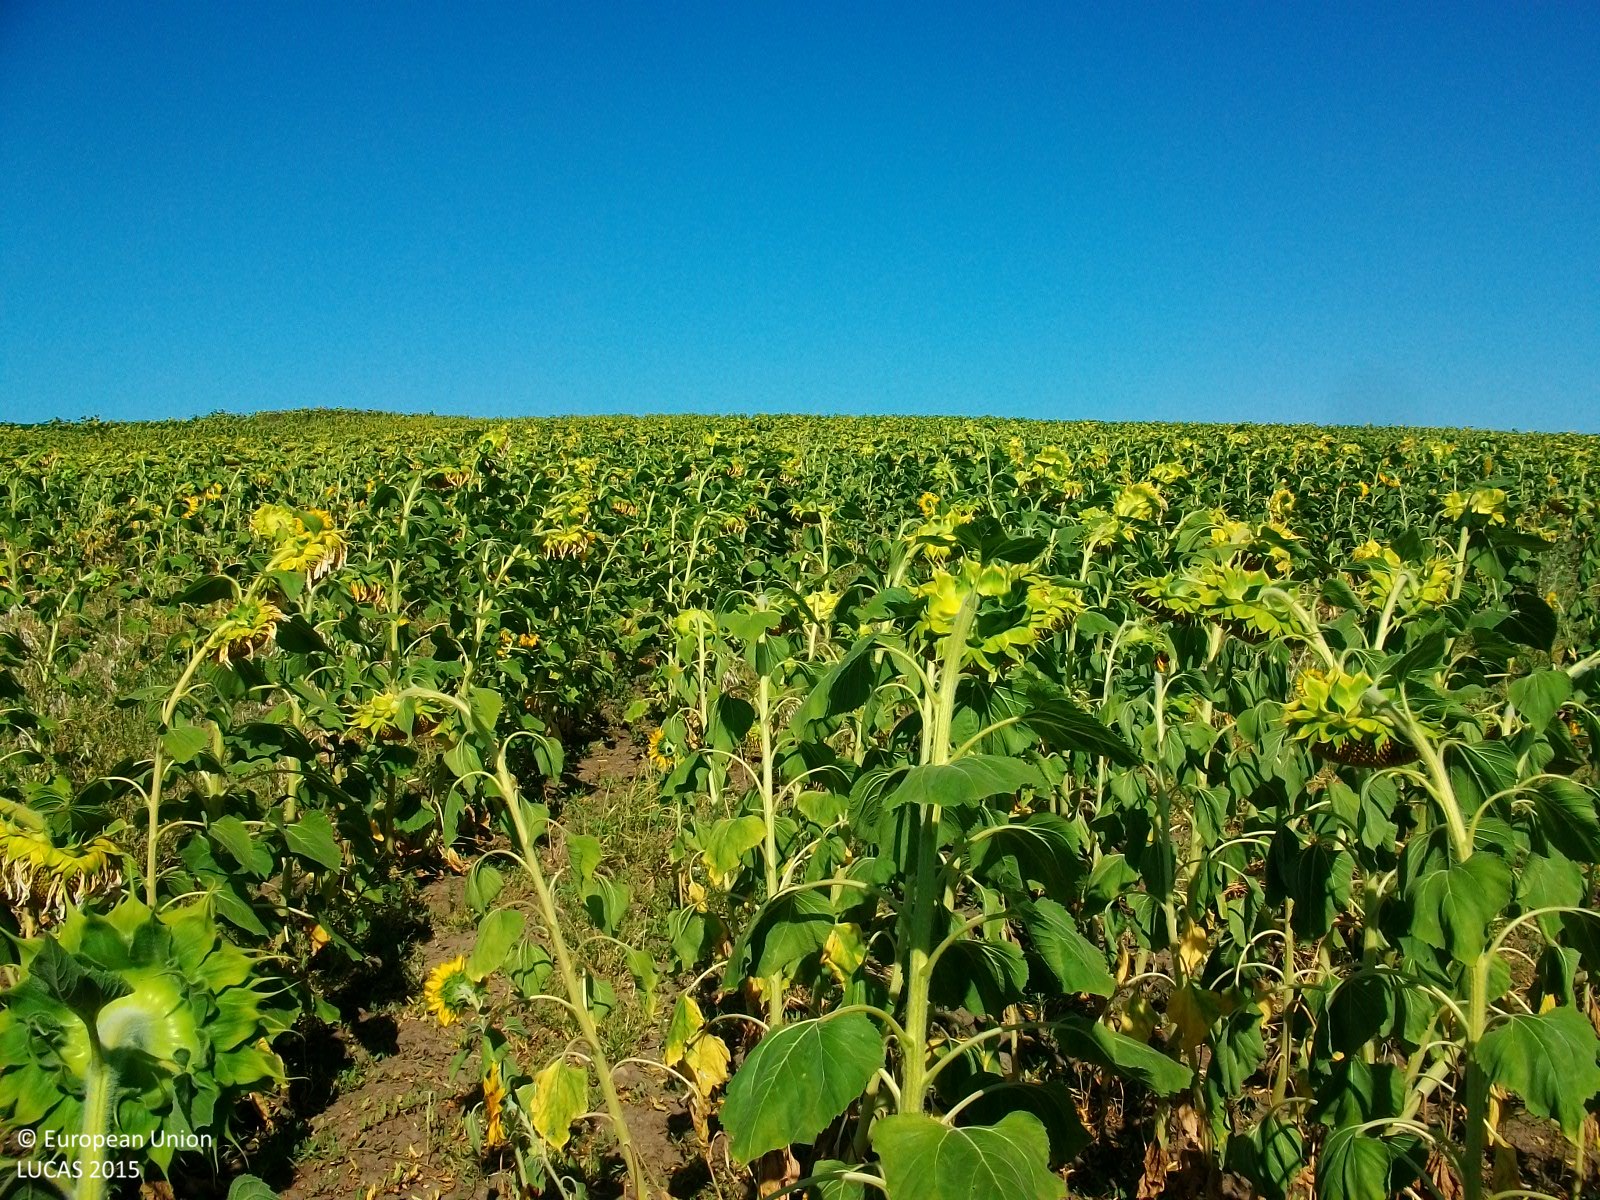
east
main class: Cropland
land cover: Sunflower
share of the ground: > 75 %
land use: Agriculture (excluding fallow land and kitchen gardens)
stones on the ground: < 10 %
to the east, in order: Sunflower
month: July
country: GR
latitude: 41.4882
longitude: 26.3034
